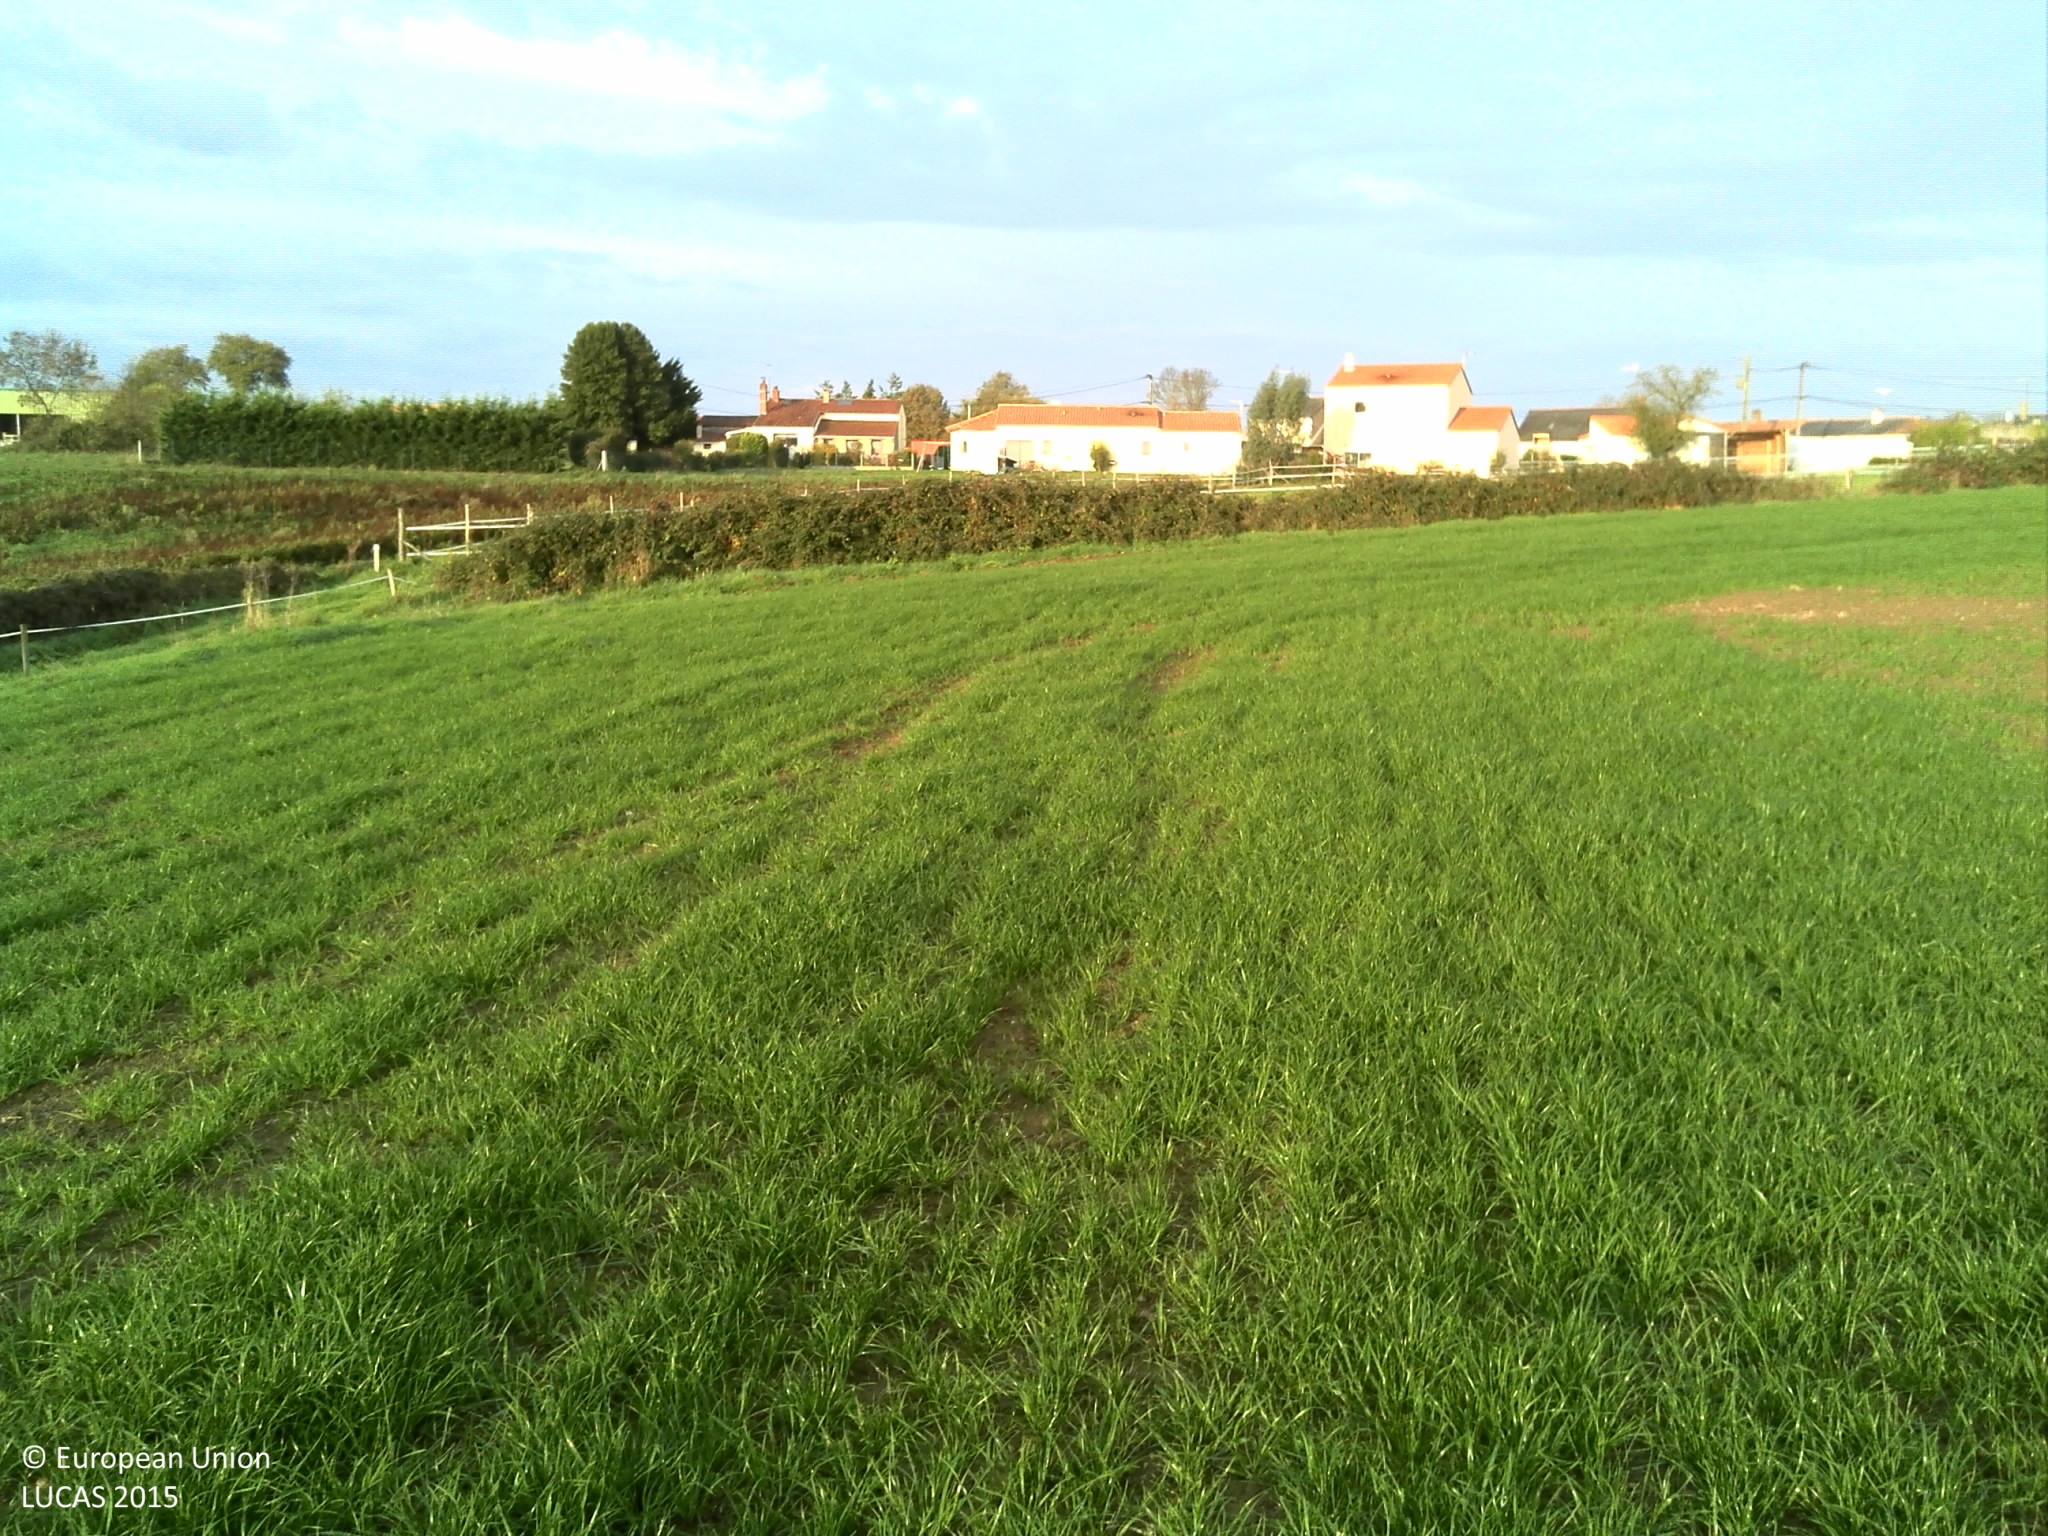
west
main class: Cropland
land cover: Temporary grasslands
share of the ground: > 75 %
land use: Agriculture (excluding fallow land and kitchen gardens)
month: November
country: FR
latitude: 47.3670
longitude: -1.3086
